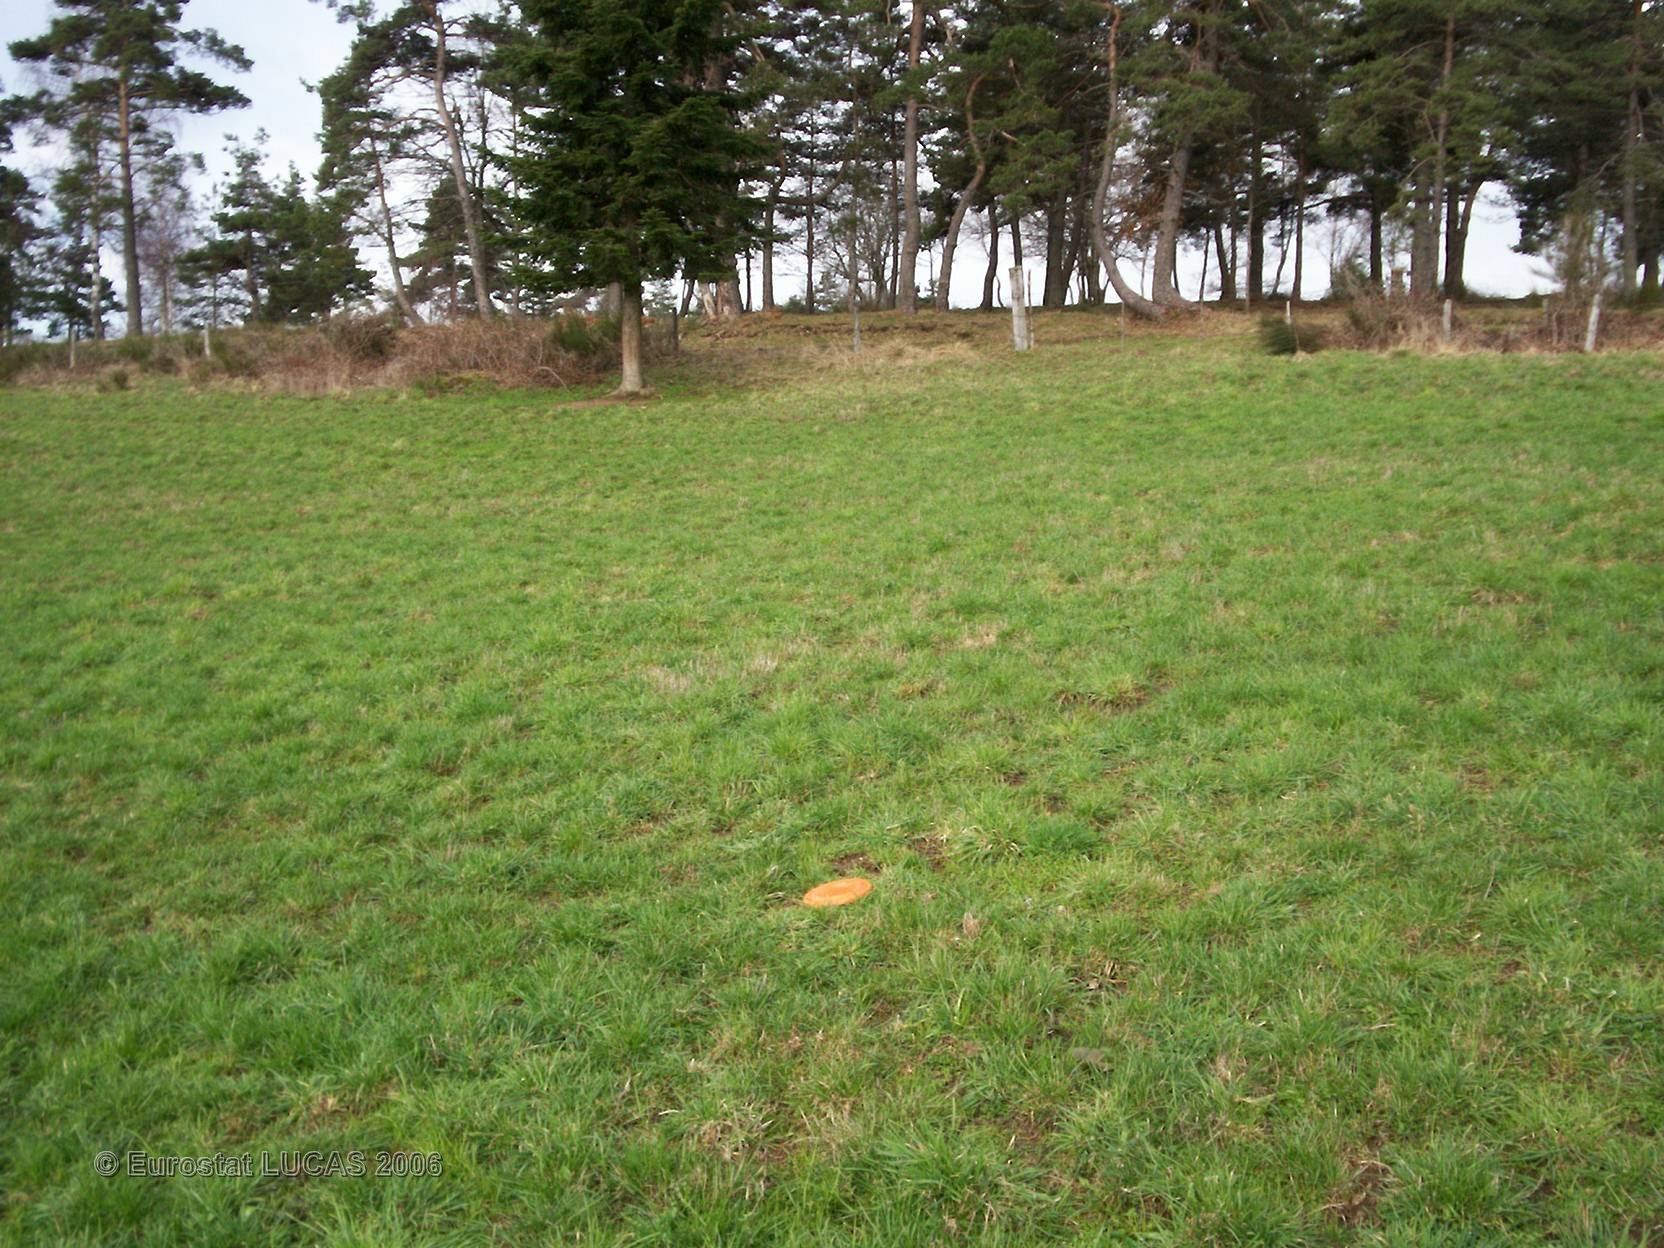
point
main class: Grassland
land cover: Grassland without tree/shrub cover
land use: Agriculture (excluding fallow land and kitchen gardens)
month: April
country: FR
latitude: 45.0832
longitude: 3.1547
